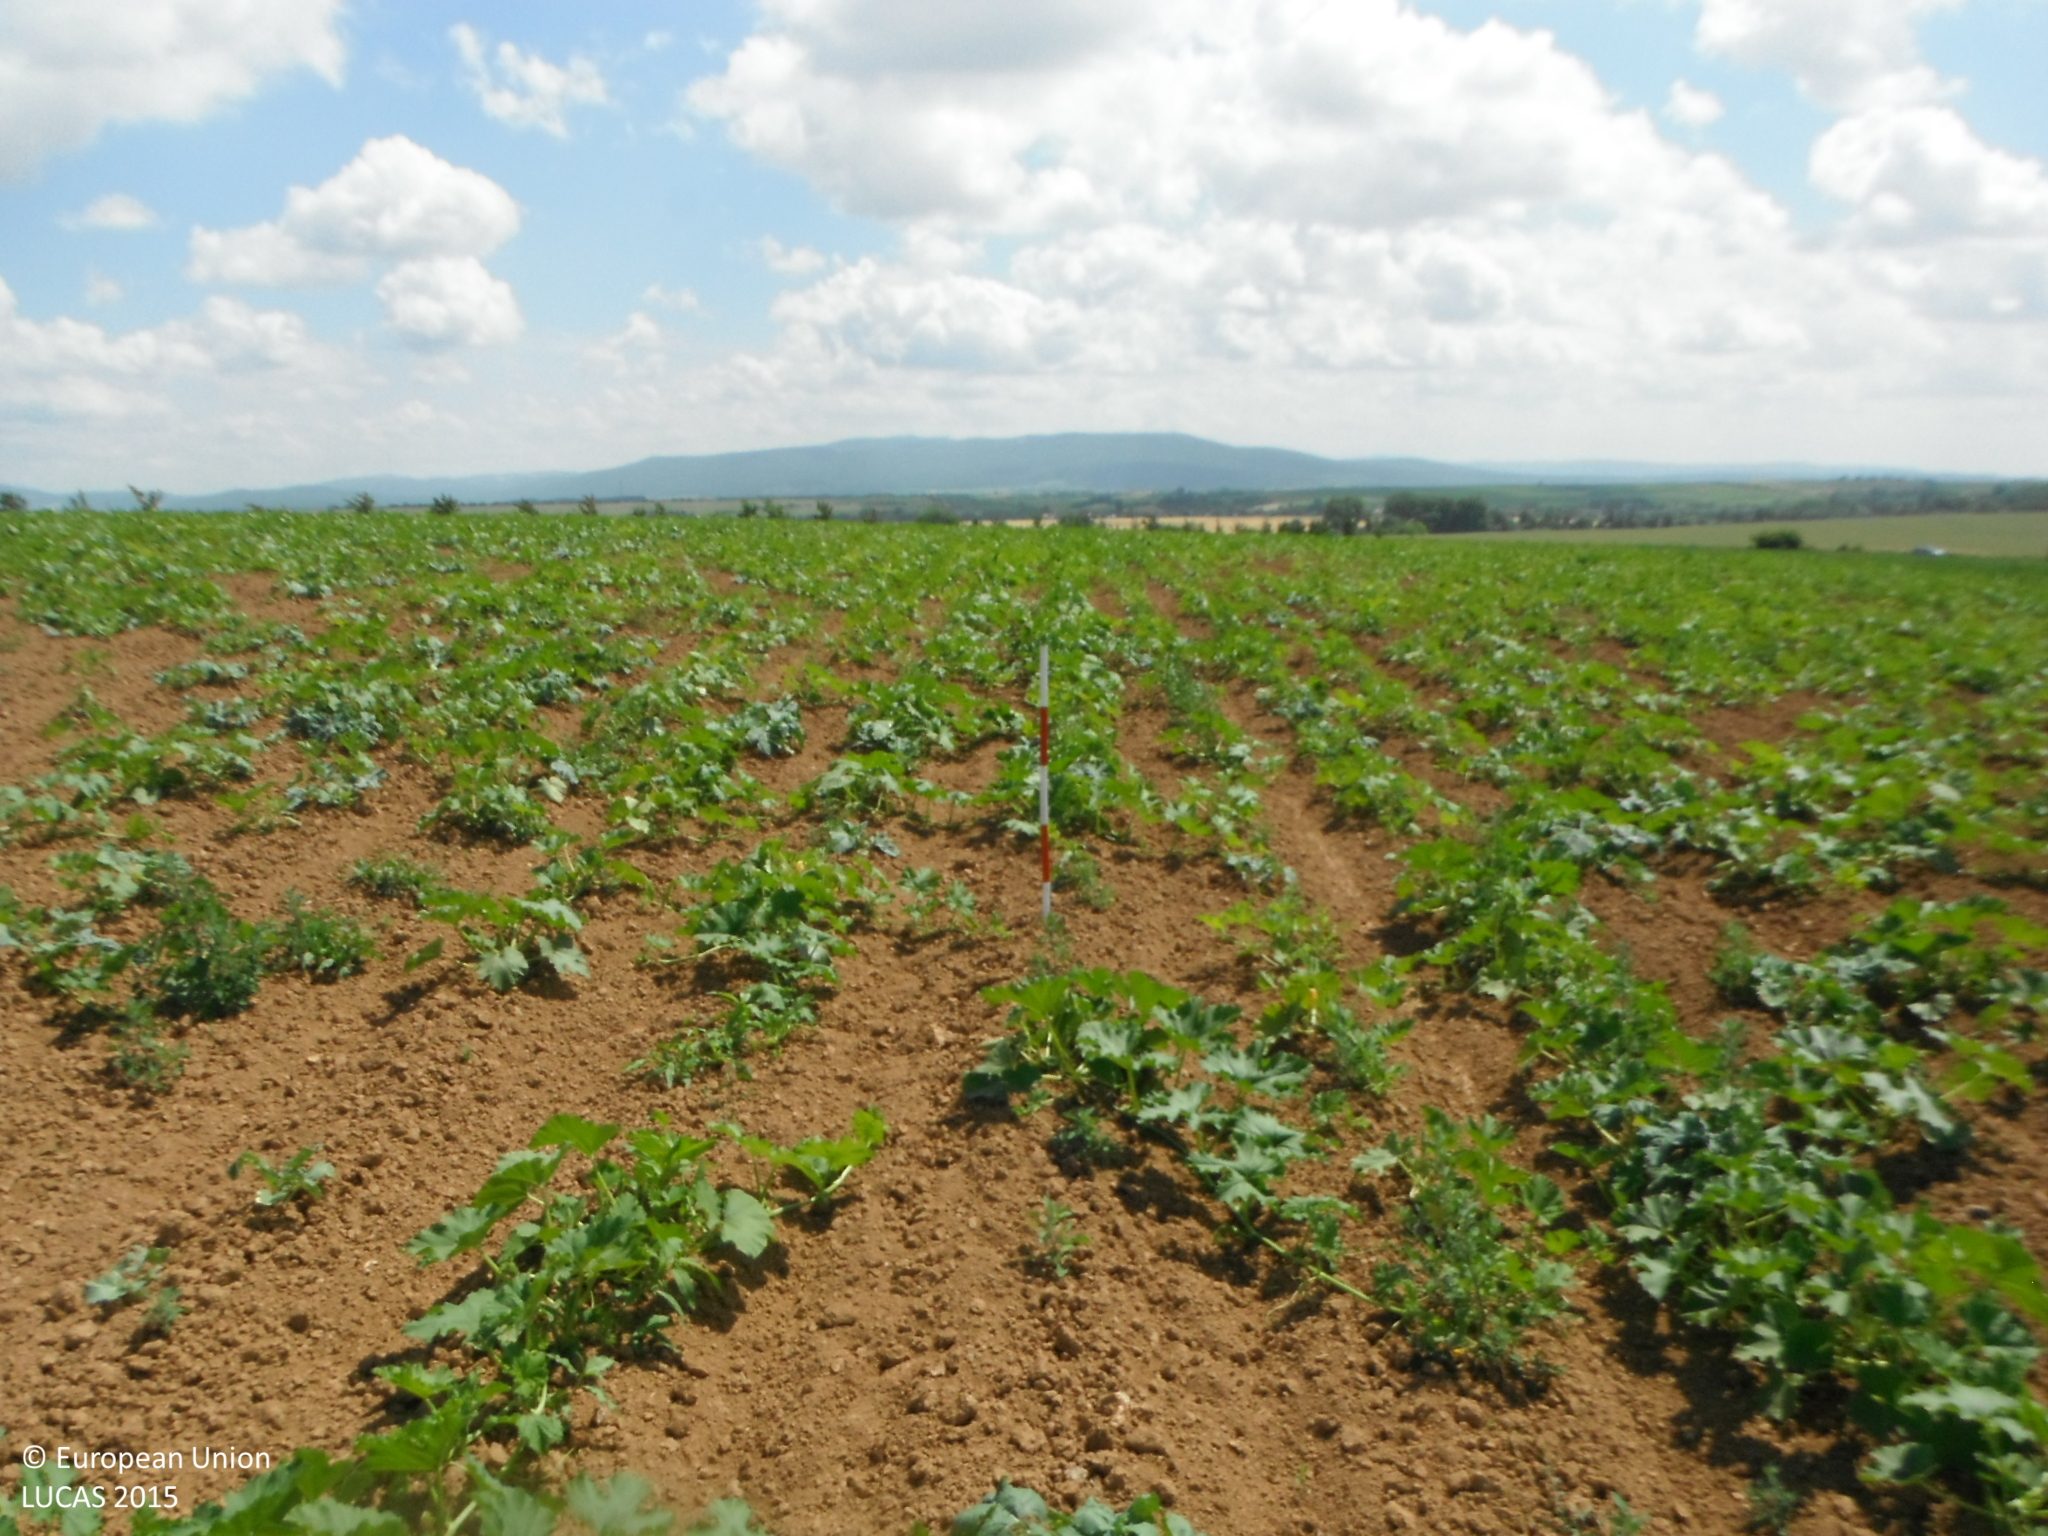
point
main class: Cropland
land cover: Other fresh vegetables
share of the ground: 25 - 50 %
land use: Agriculture (excluding fallow land and kitchen gardens)
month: June
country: SK
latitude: 48.3989
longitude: 18.2949
